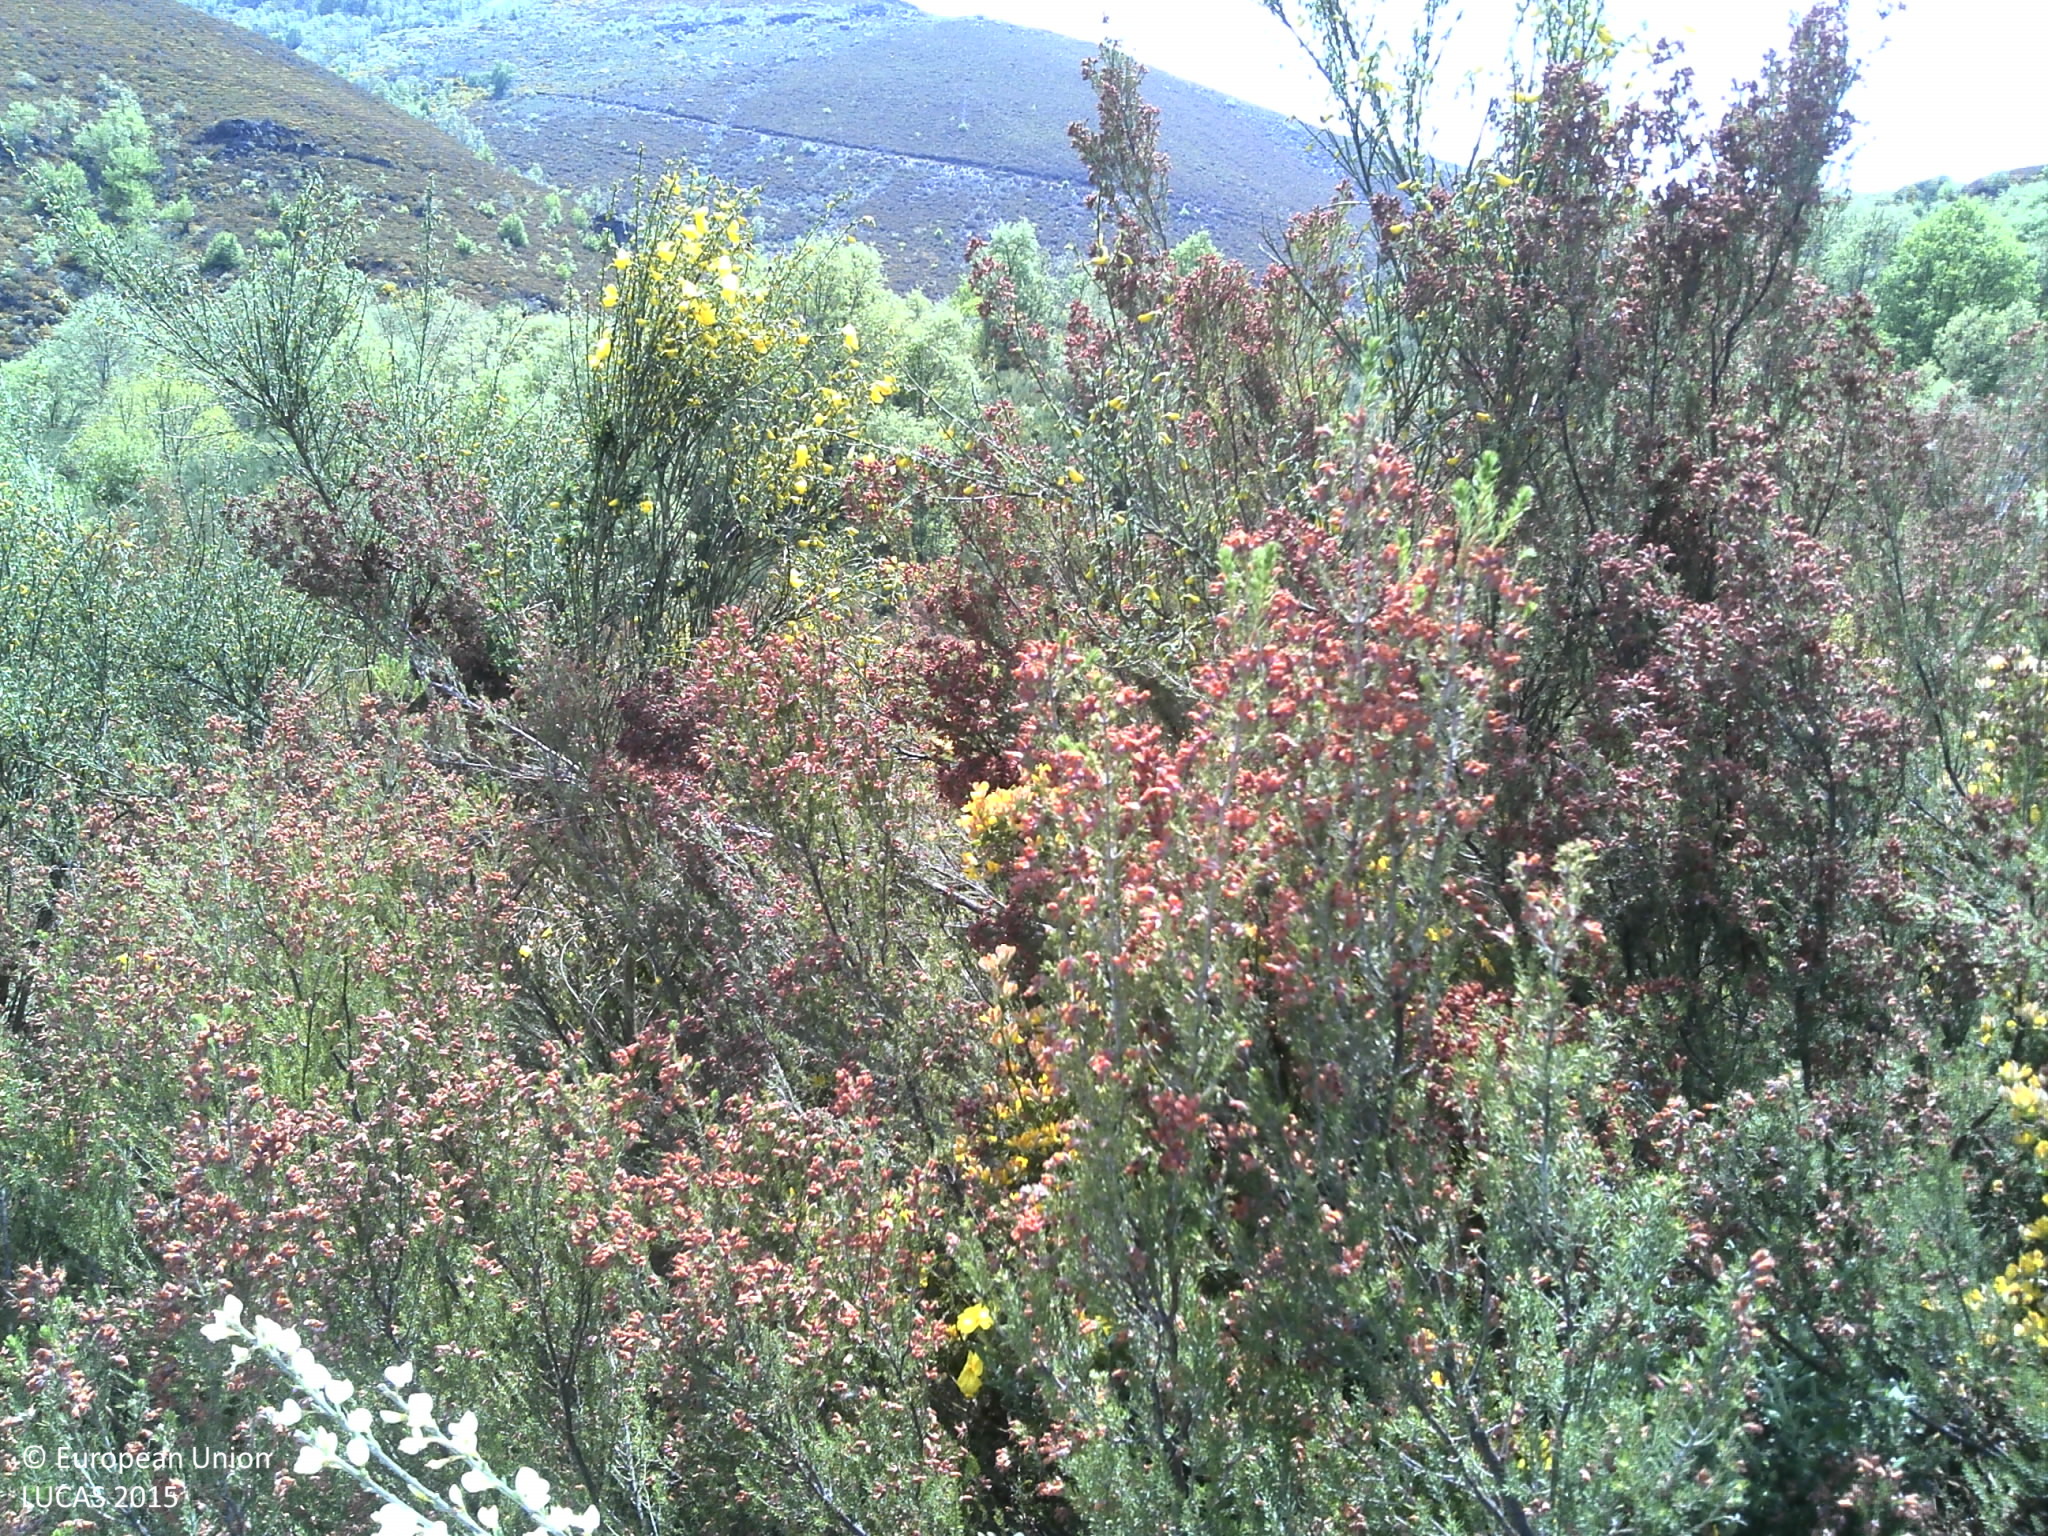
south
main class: Shrubland
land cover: Shrubland with sparse tree cover
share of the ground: > 75 %
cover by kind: shrubs 85 %, herbaceous plants 10 %, broadleaved forest trees 5 %
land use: Forestry
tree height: < 5 m
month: May
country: PT
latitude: 41.9338
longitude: -7.0426
